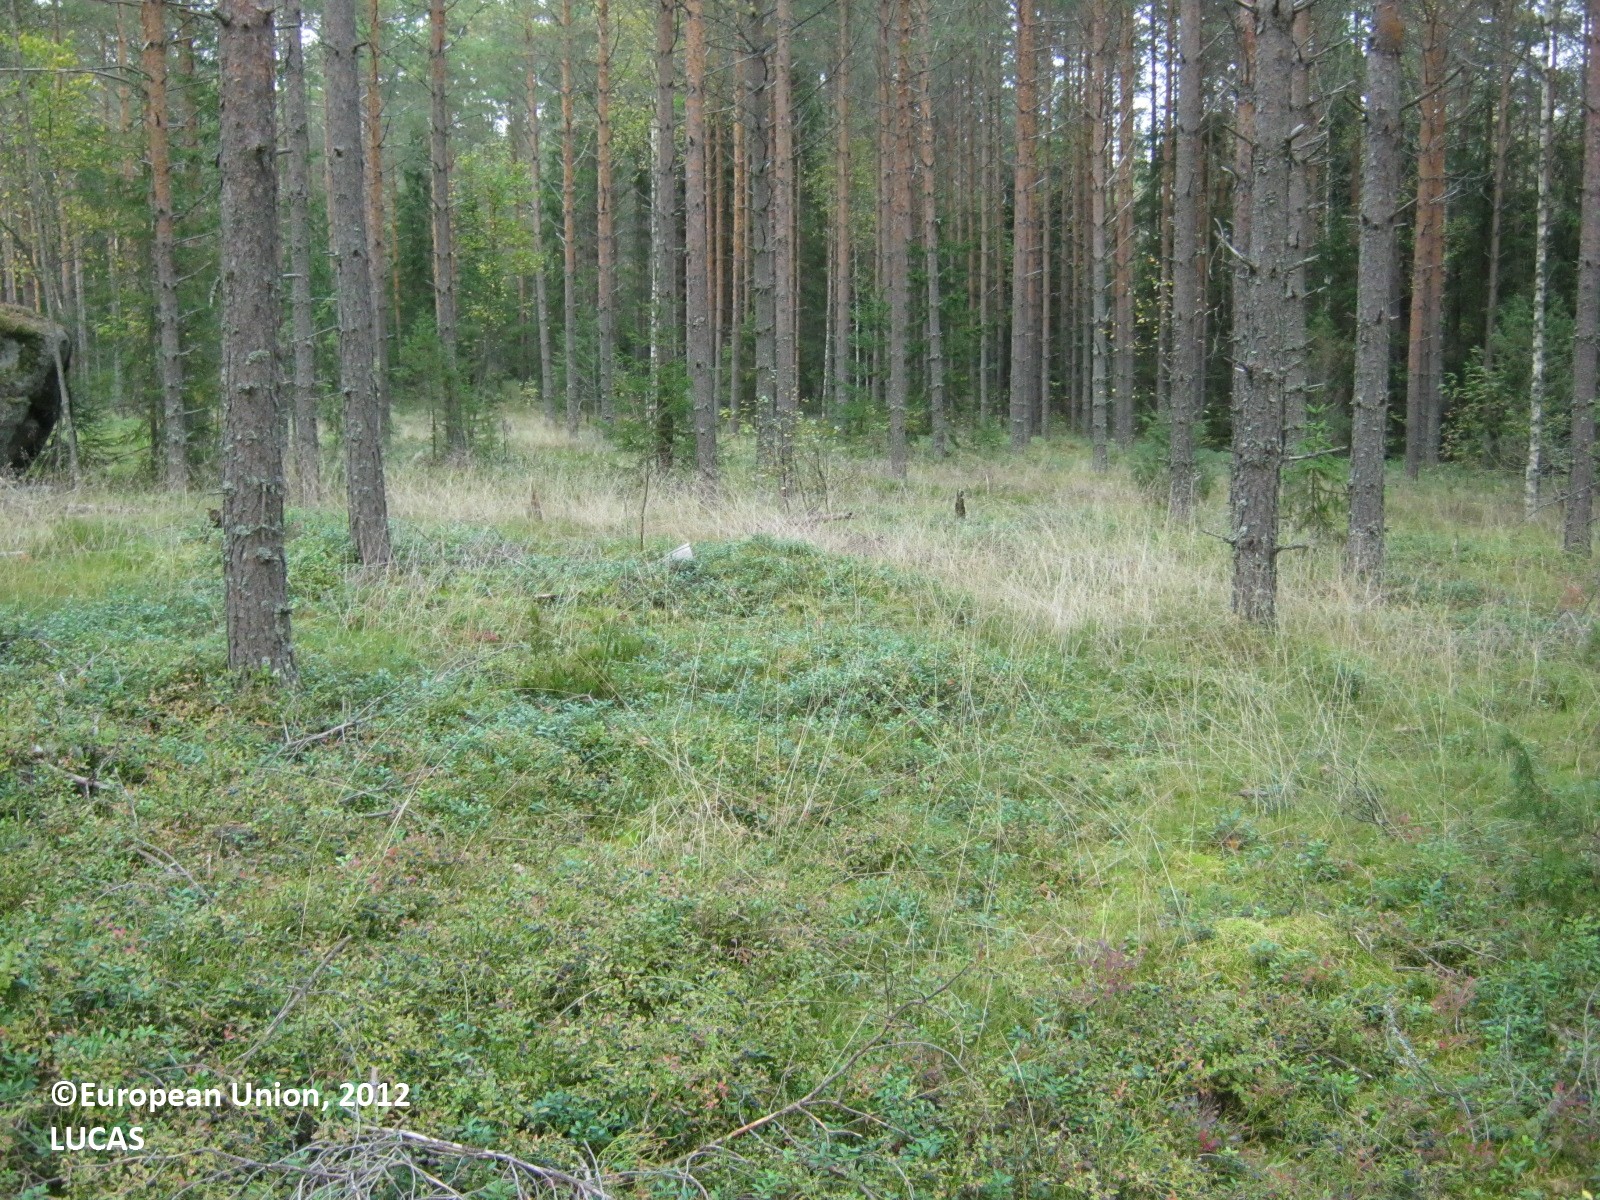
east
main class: Woodland
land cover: Pine dominated coniferous woodland
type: boreal forest
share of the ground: 50 - 75 %
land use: Forestry
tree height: > 5 m
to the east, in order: Pine dominated coniferous woodland; Spruce dominated coniferous woodland; Pine dominated coniferous woodland
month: September
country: FI
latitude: 60.8006
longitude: 28.0452
